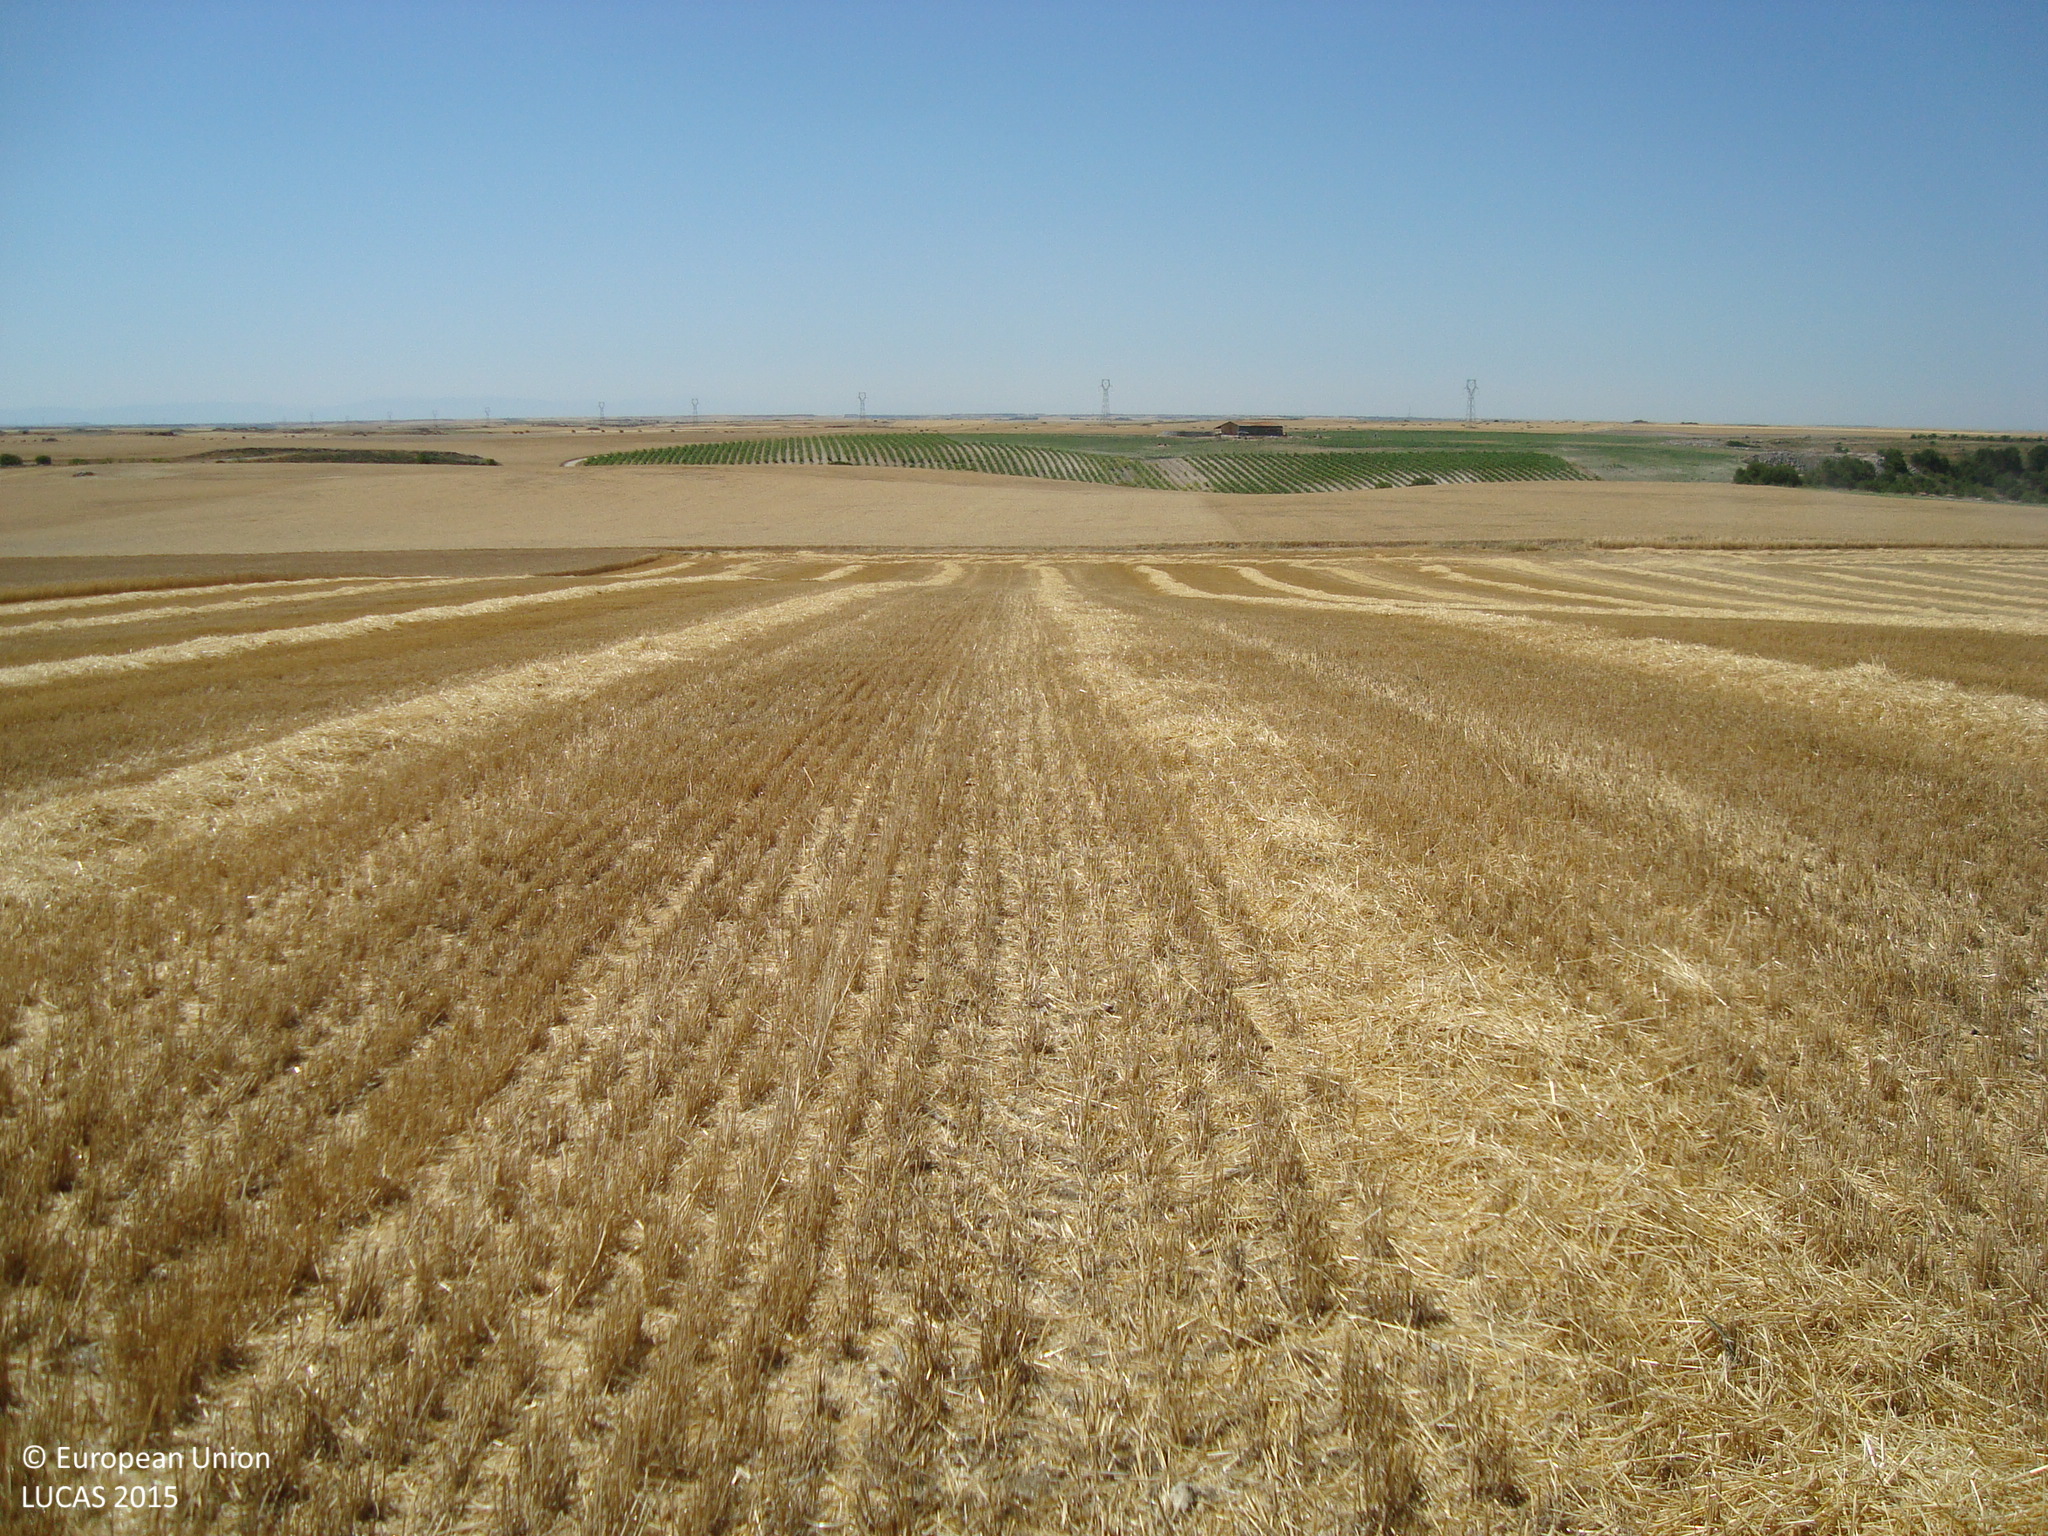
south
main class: Cropland
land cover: Barley
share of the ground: < 10 %
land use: Agriculture (excluding fallow land and kitchen gardens)
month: July
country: ES
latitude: 41.6801
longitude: -4.1021
